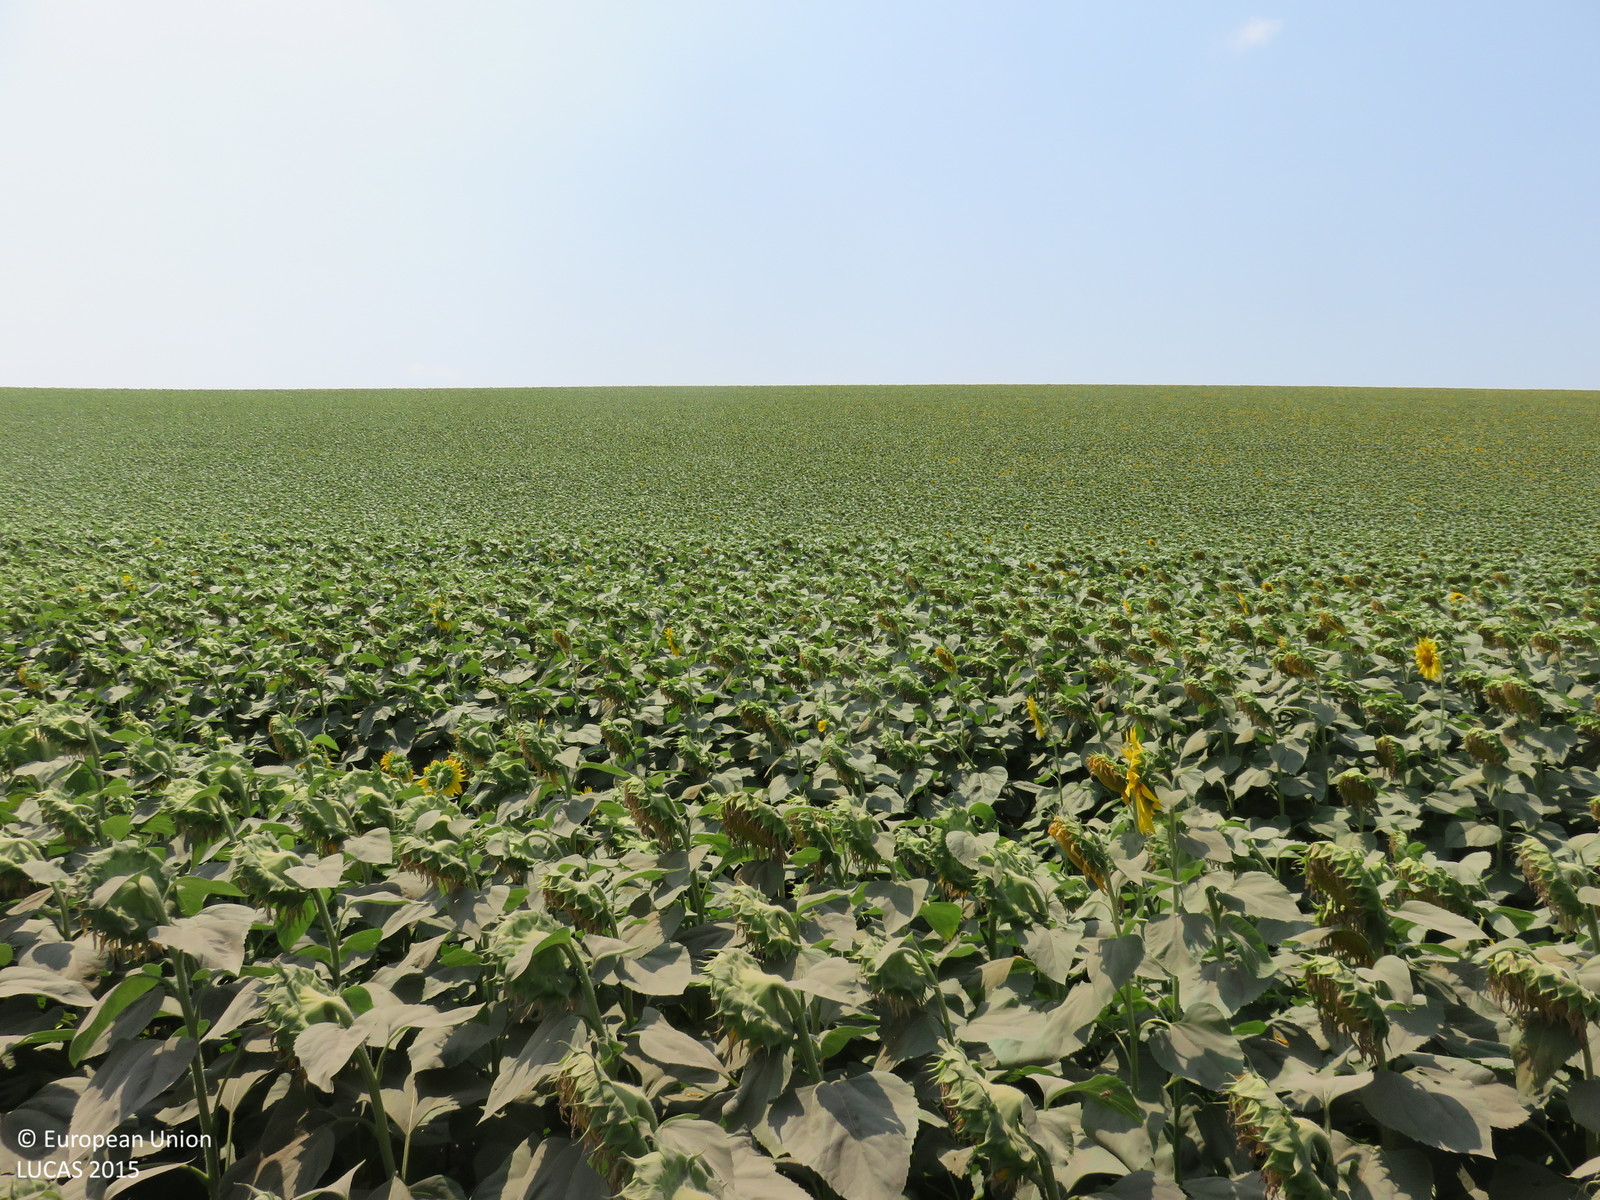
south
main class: Cropland
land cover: Sunflower
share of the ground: > 75 %
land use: Agriculture (excluding fallow land and kitchen gardens)
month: July
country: BG
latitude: 43.5441
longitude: 25.1366
